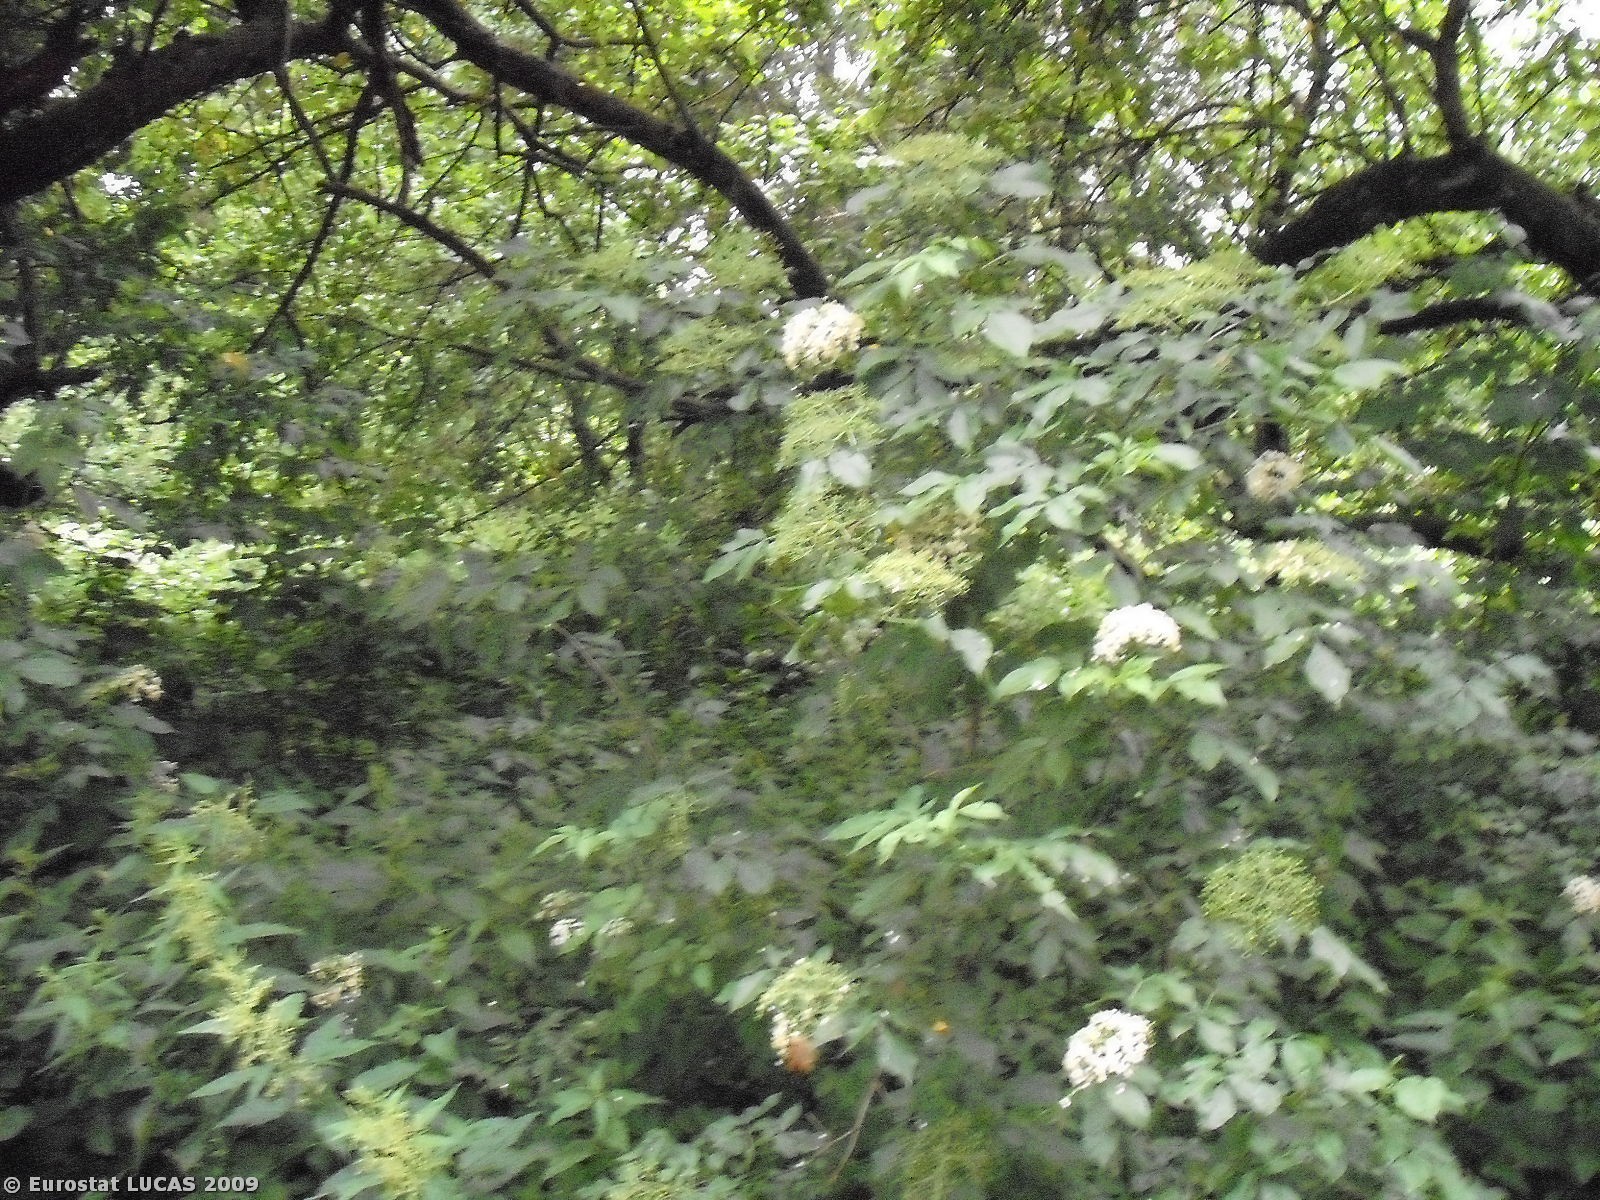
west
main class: Woodland
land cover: Broadleaved woodland
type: mesophytic deciduous forest
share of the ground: > 75 %
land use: Unused
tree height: > 5 m
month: June
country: PL
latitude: 50.7859
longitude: 21.2676
